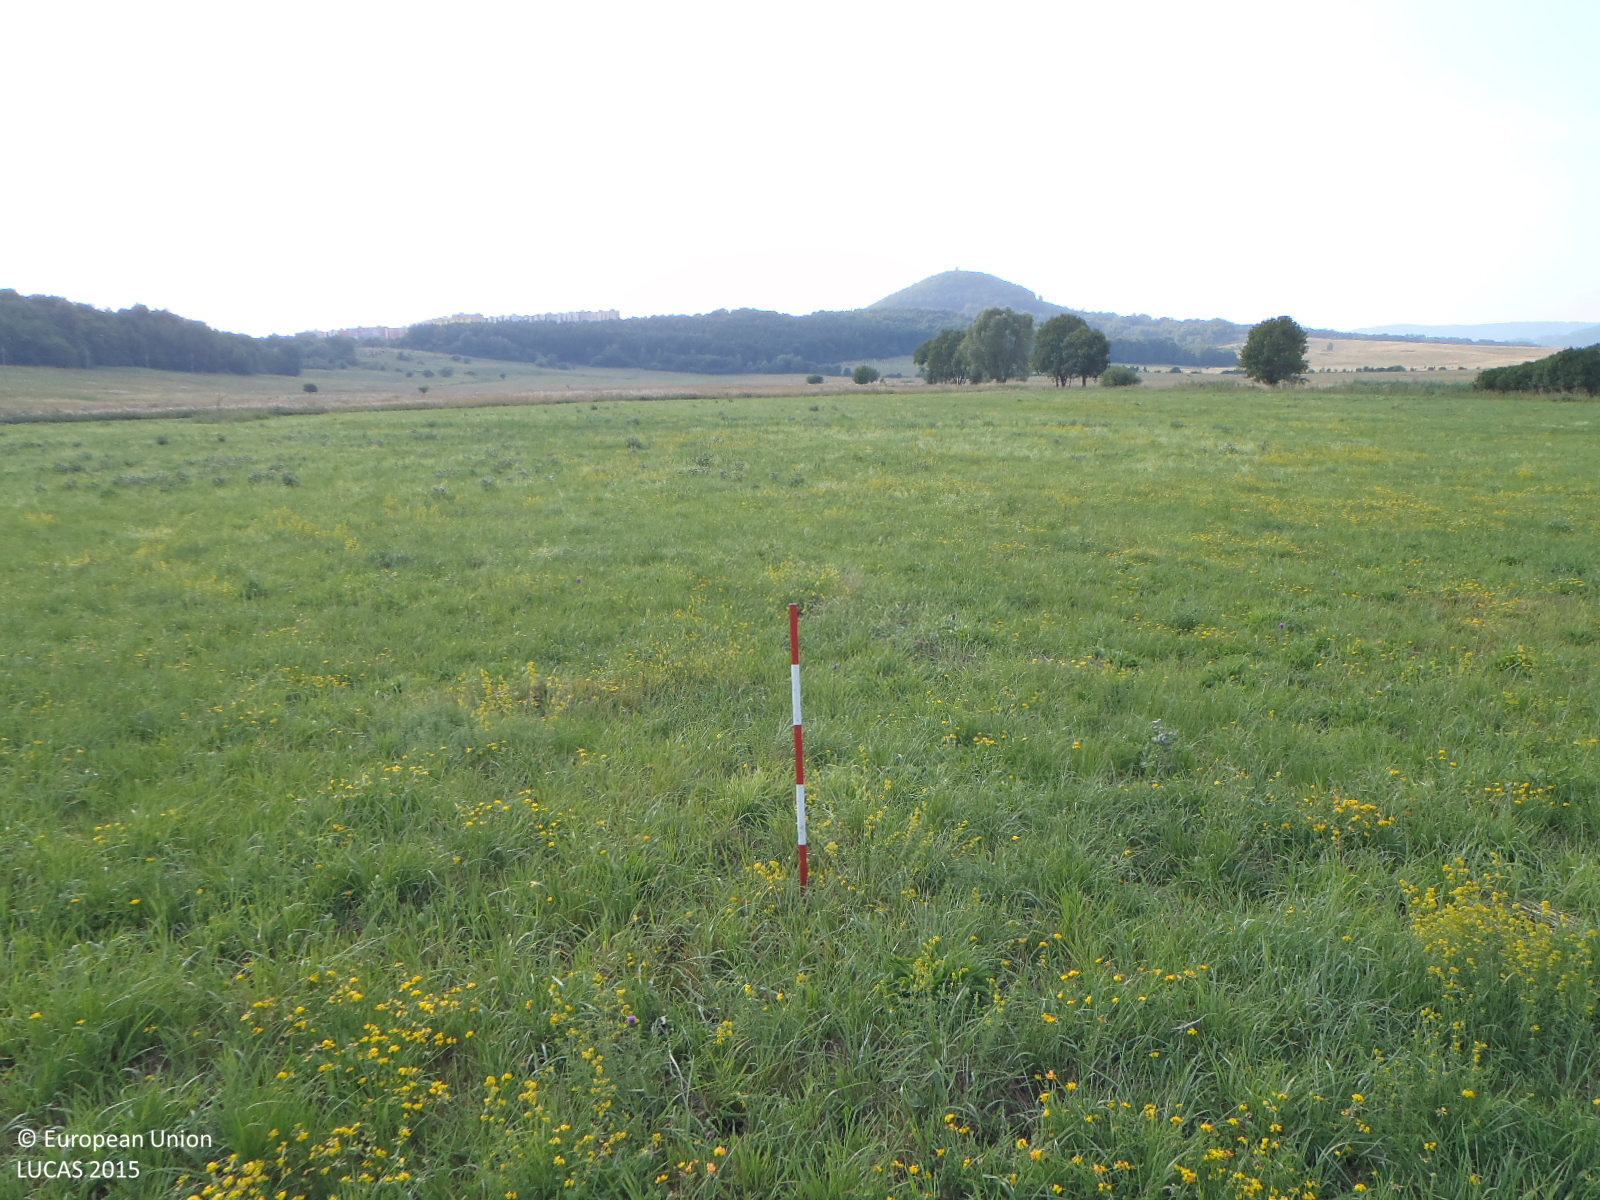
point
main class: Grassland
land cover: Grassland without tree/shrub cover
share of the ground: > 75 %
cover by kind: herbaceous plants 100 %
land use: Agriculture (excluding fallow land and kitchen gardens)
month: August
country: CZ
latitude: 50.6868
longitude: 14.5738
